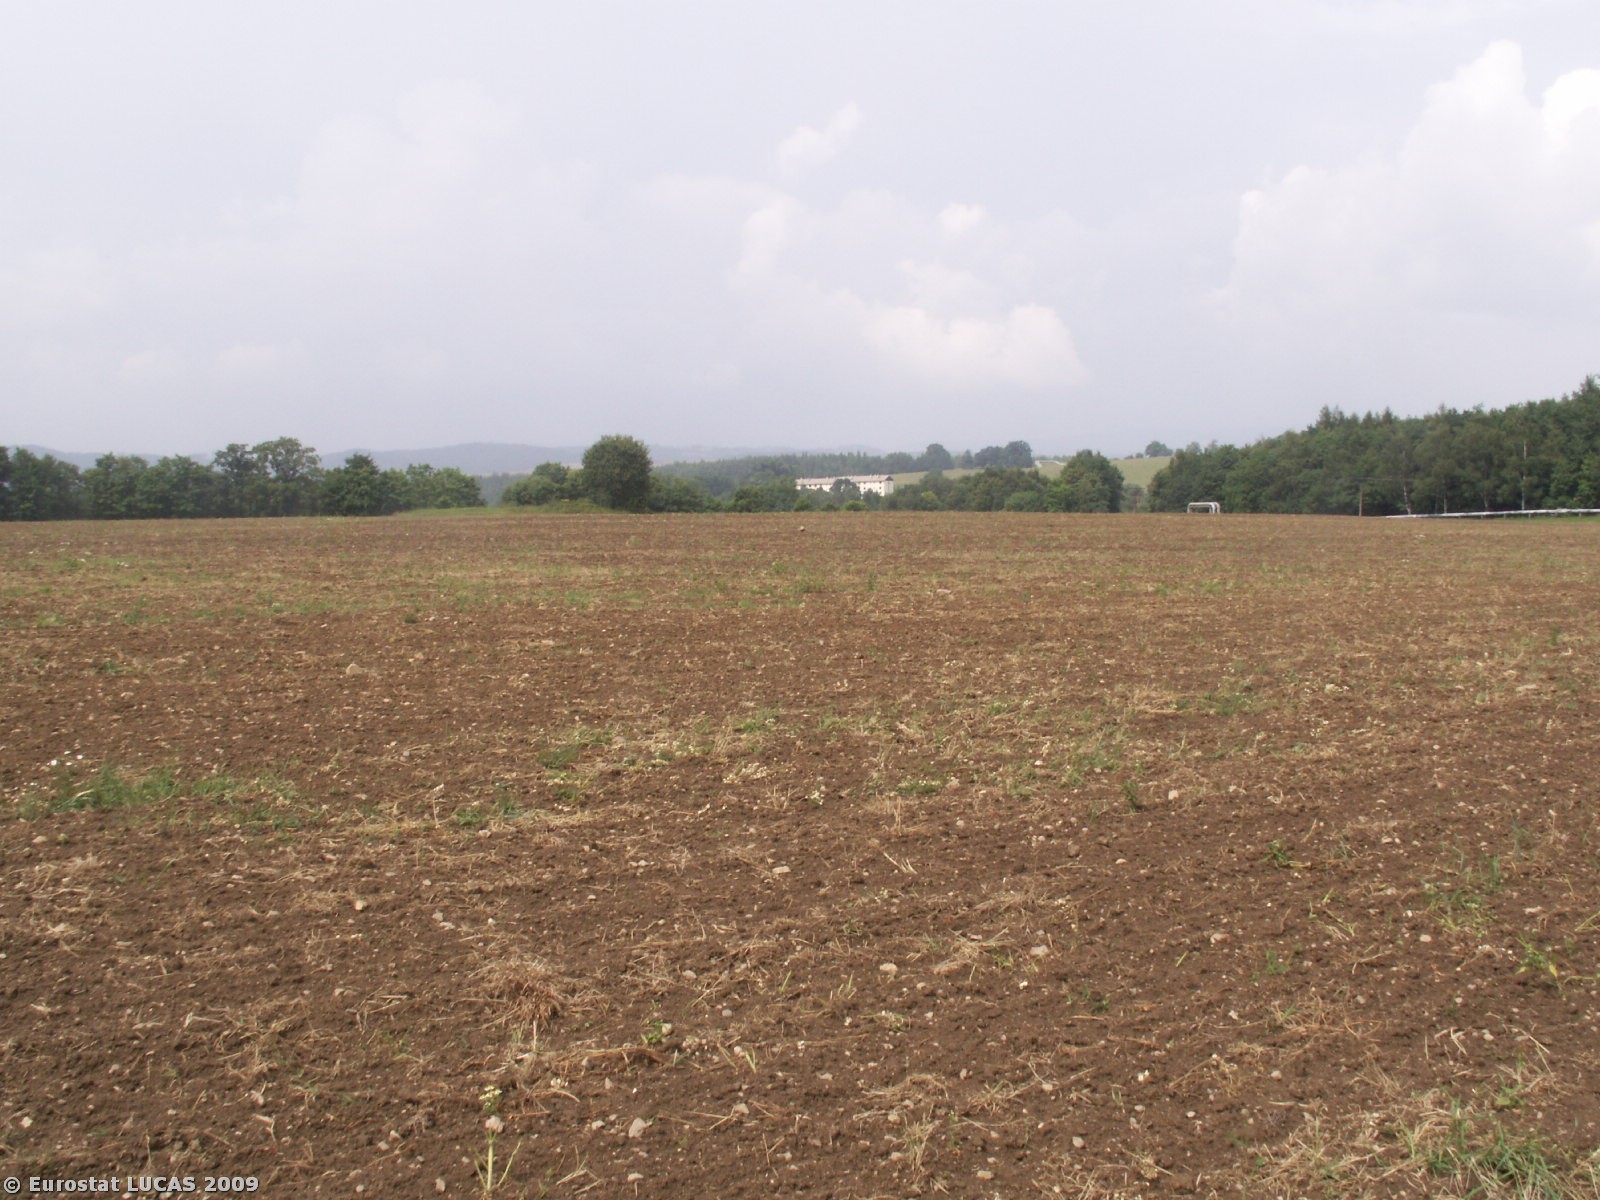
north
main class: Cropland
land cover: Other fibre and oleaginous crops
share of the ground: < 10 %
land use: Agriculture (excluding fallow land and kitchen gardens)
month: June
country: CZ
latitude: 50.2415
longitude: 12.7340
